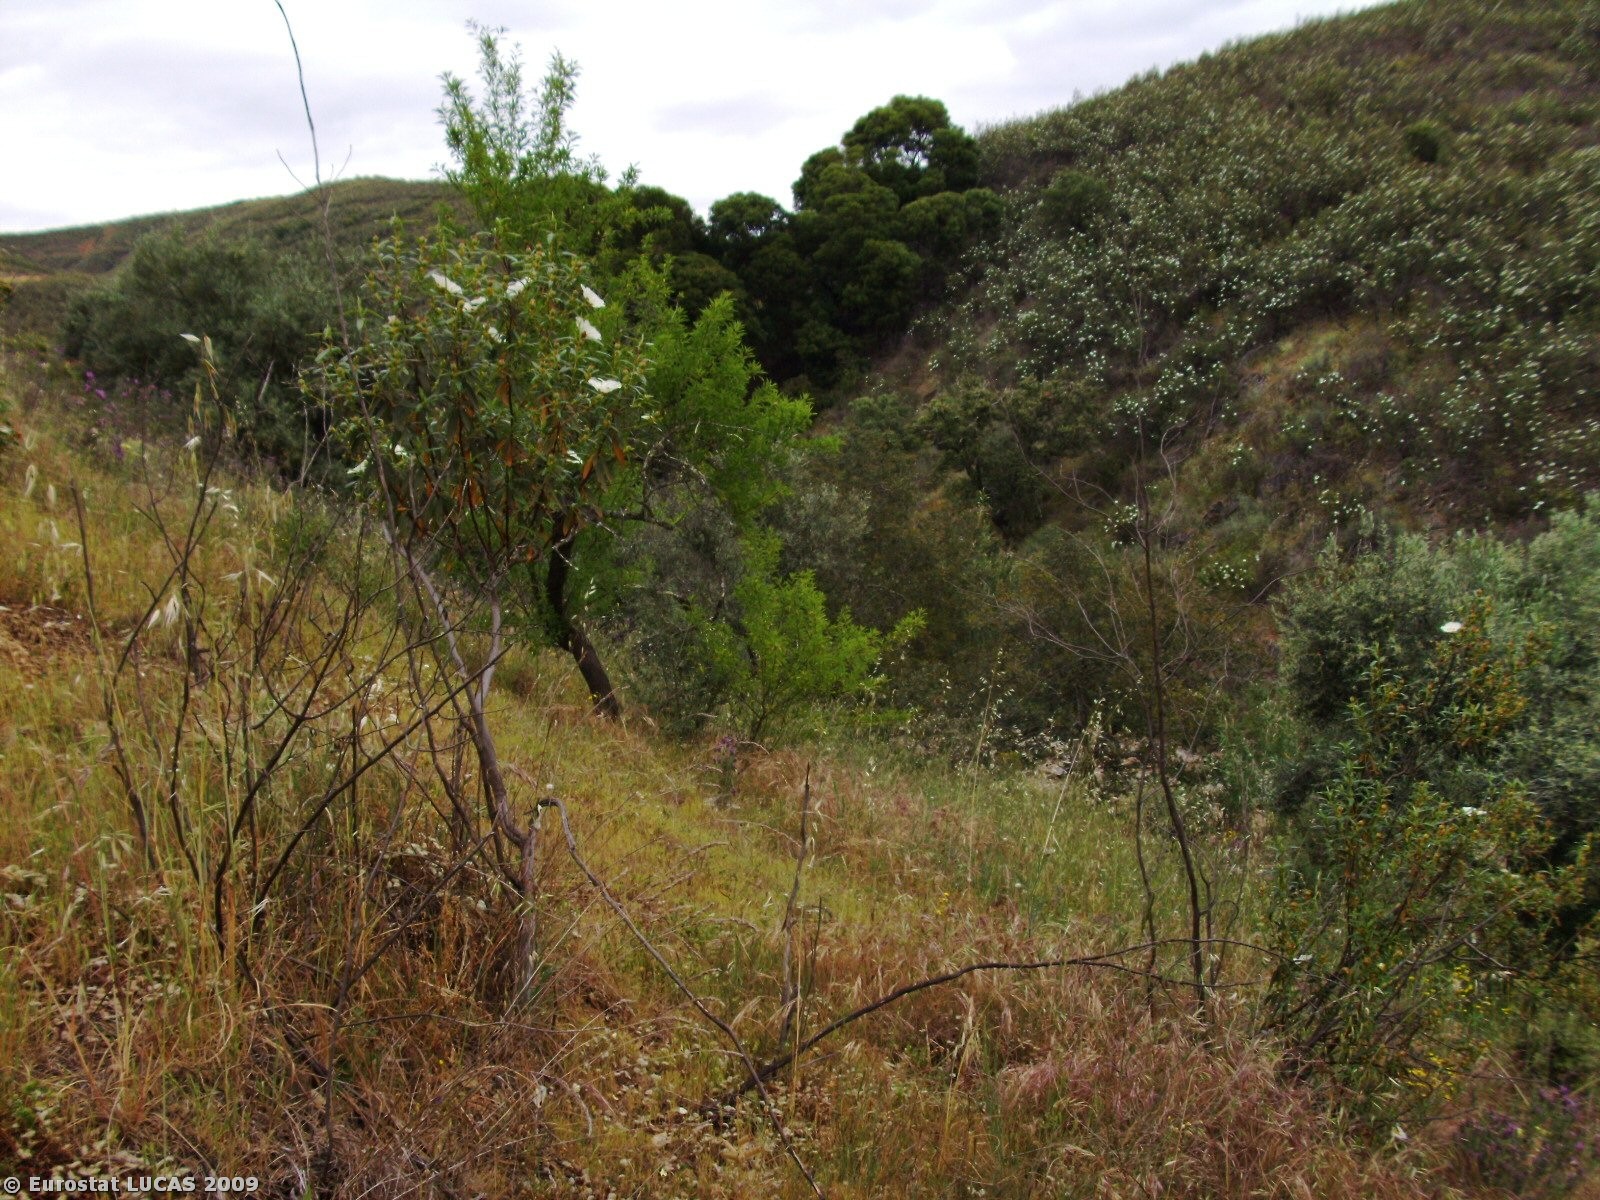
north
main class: Shrubland
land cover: Shrubland with sparse tree cover
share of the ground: 25 - 50 %
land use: Unused
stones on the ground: 25 - 50 %
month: April
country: PT
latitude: 37.2697
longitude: -7.6333
